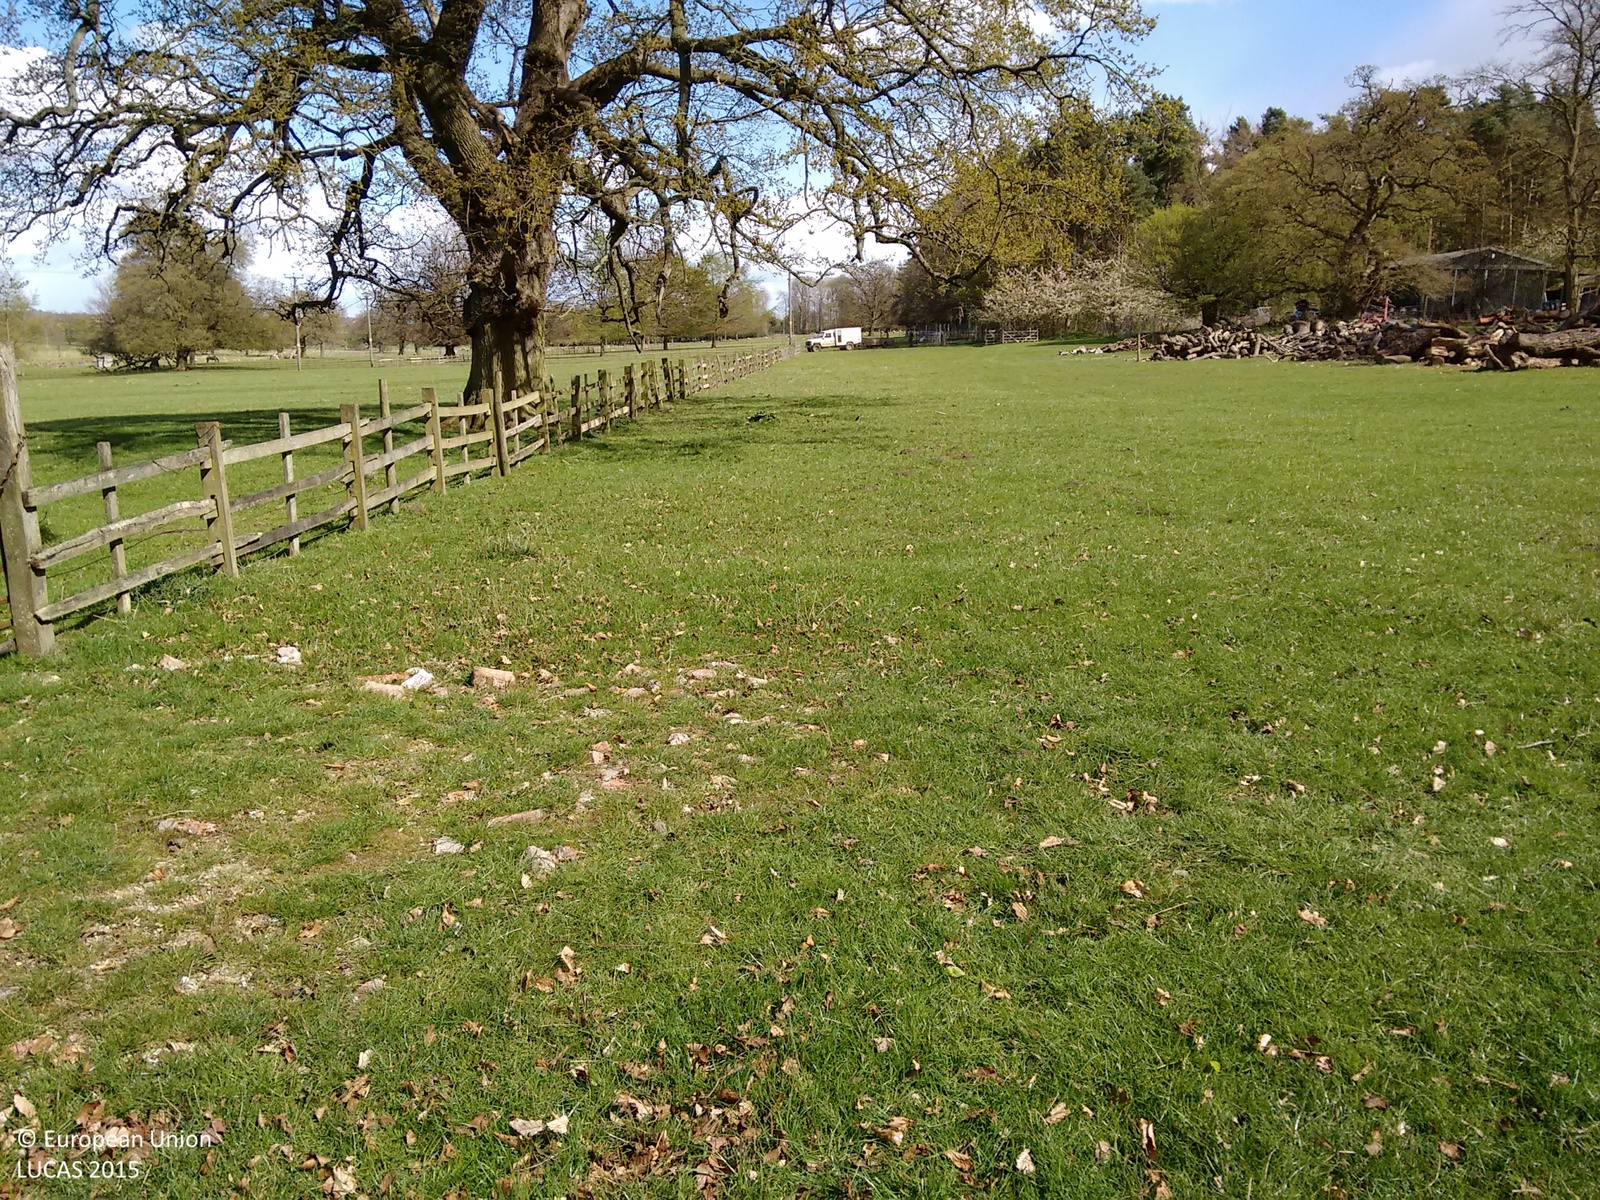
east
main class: Grassland
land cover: Grassland without tree/shrub cover
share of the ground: > 75 %
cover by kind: herbaceous plants 100 %
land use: Agriculture (excluding fallow land and kitchen gardens)
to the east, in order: Grassland without tree/shrub cover; Fences; Single bushes/trees; Grassland without tree/shrub cover; Fences; Single bushes/trees; Grassland without tree/shrub cover; Single bushes/trees; Grassland without tree/shrub cover; Fences; Grassland without tree/shrub cover
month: April
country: GB
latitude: 53.1777
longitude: -0.1027
